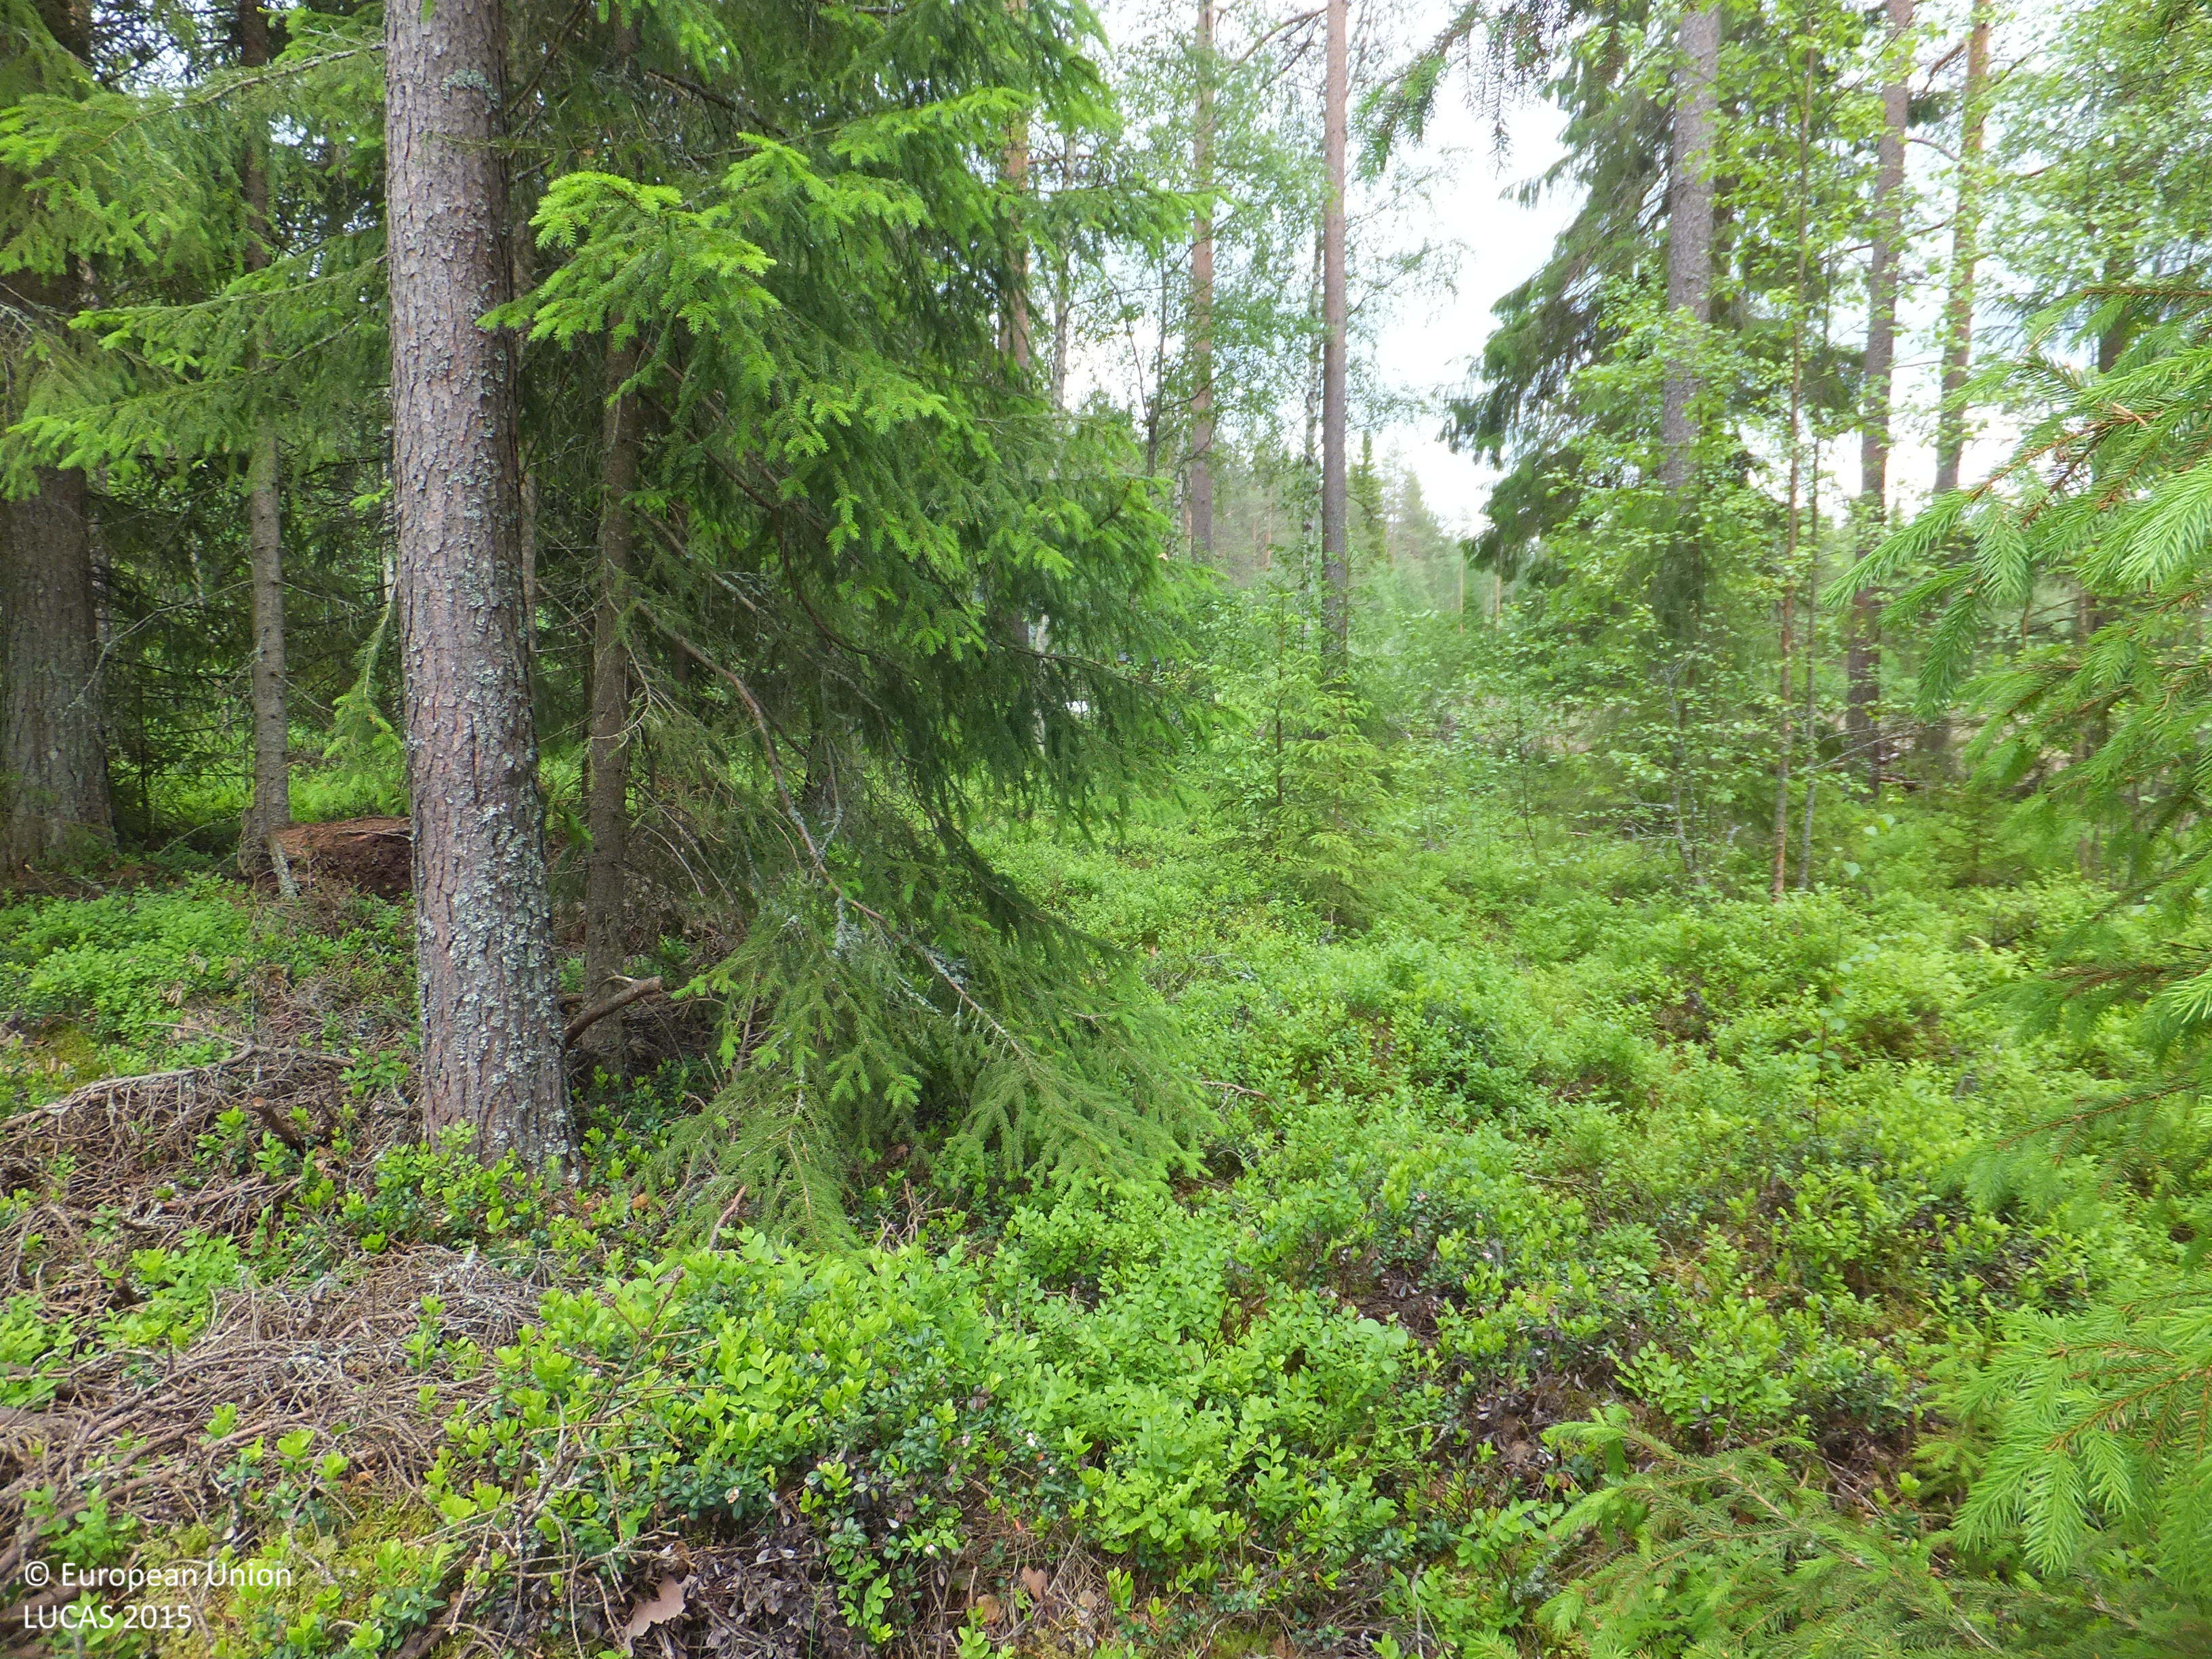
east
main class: Woodland
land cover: Other mixed woodland
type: boreal forest
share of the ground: > 75 %
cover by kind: coniferous forest trees 55 %, broadleaved forest trees 20 %, shrubs 15 %, lichens and mosses 10 %
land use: Forestry
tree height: > 5 m
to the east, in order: Other mixed woodland; Artificial constructions in urban areas; Other mixed woodland; Pine dominated mixed woodland; Tracks
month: June
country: FI
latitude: 63.4877
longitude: 24.1080
